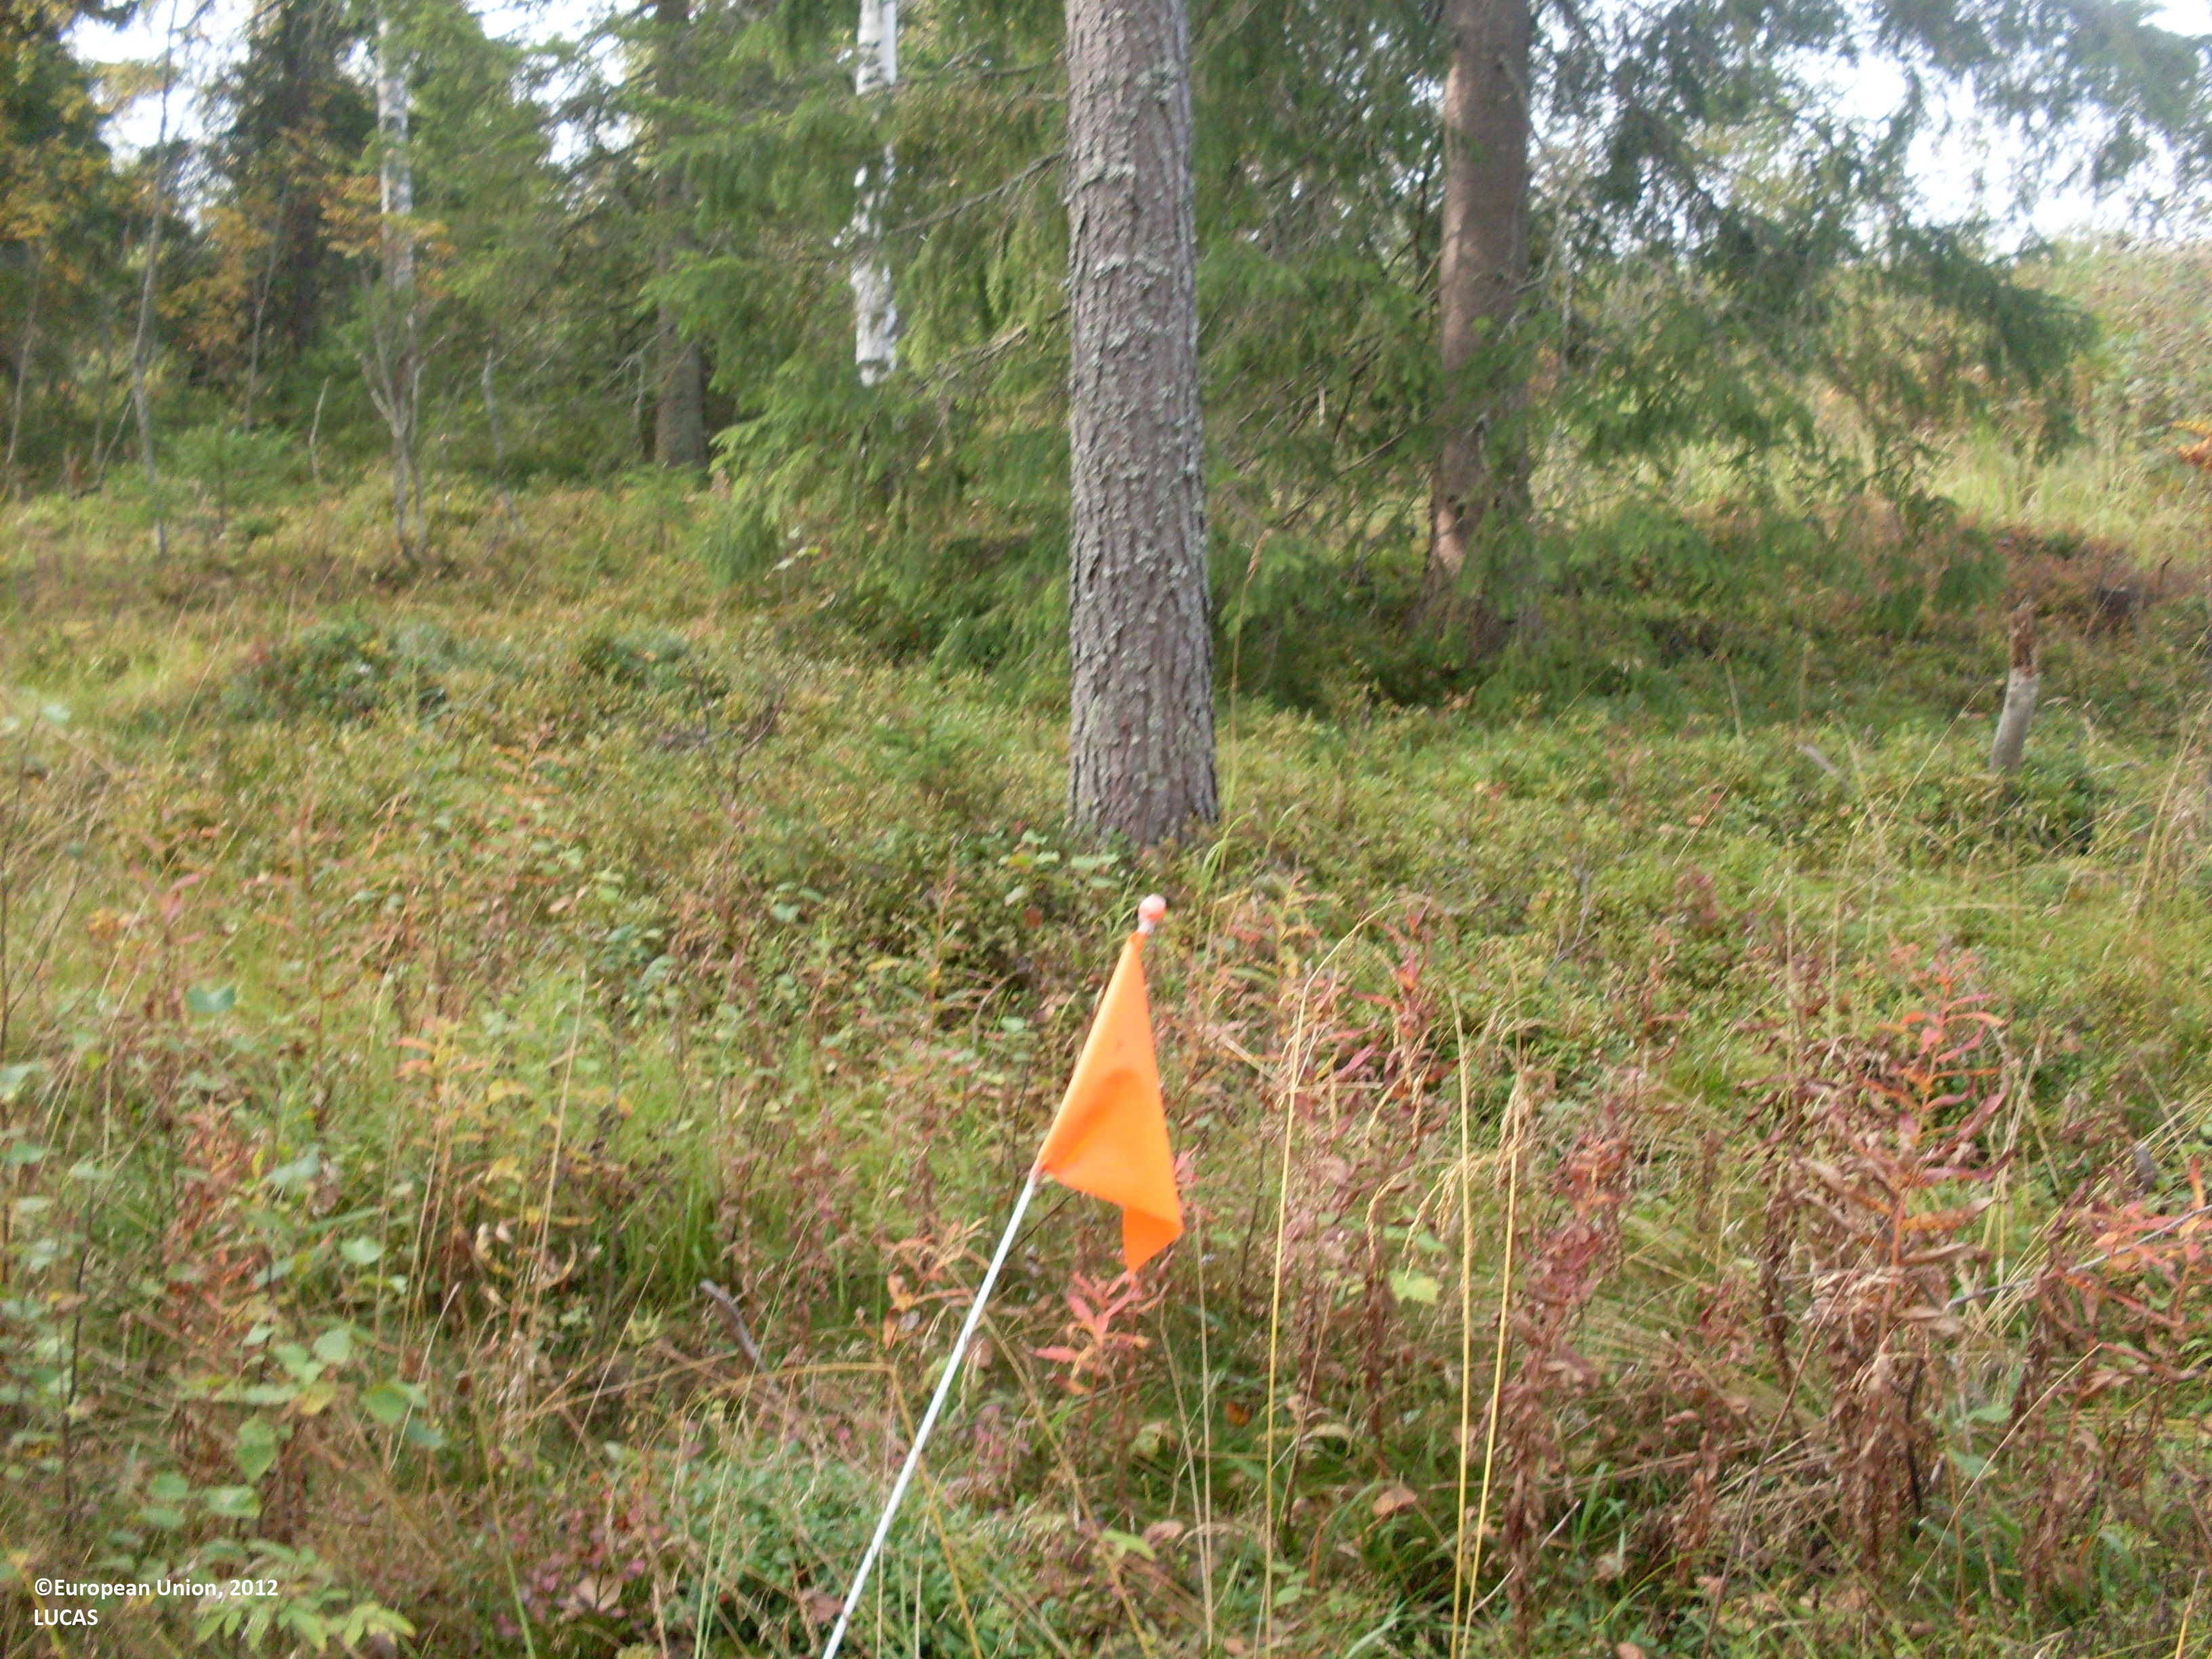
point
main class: Woodland
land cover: Other mixed woodland
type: boreal forest
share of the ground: 50 - 75 %
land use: Forestry
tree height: > 5 m
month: September
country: FI
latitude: 64.2341
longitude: 29.3665
